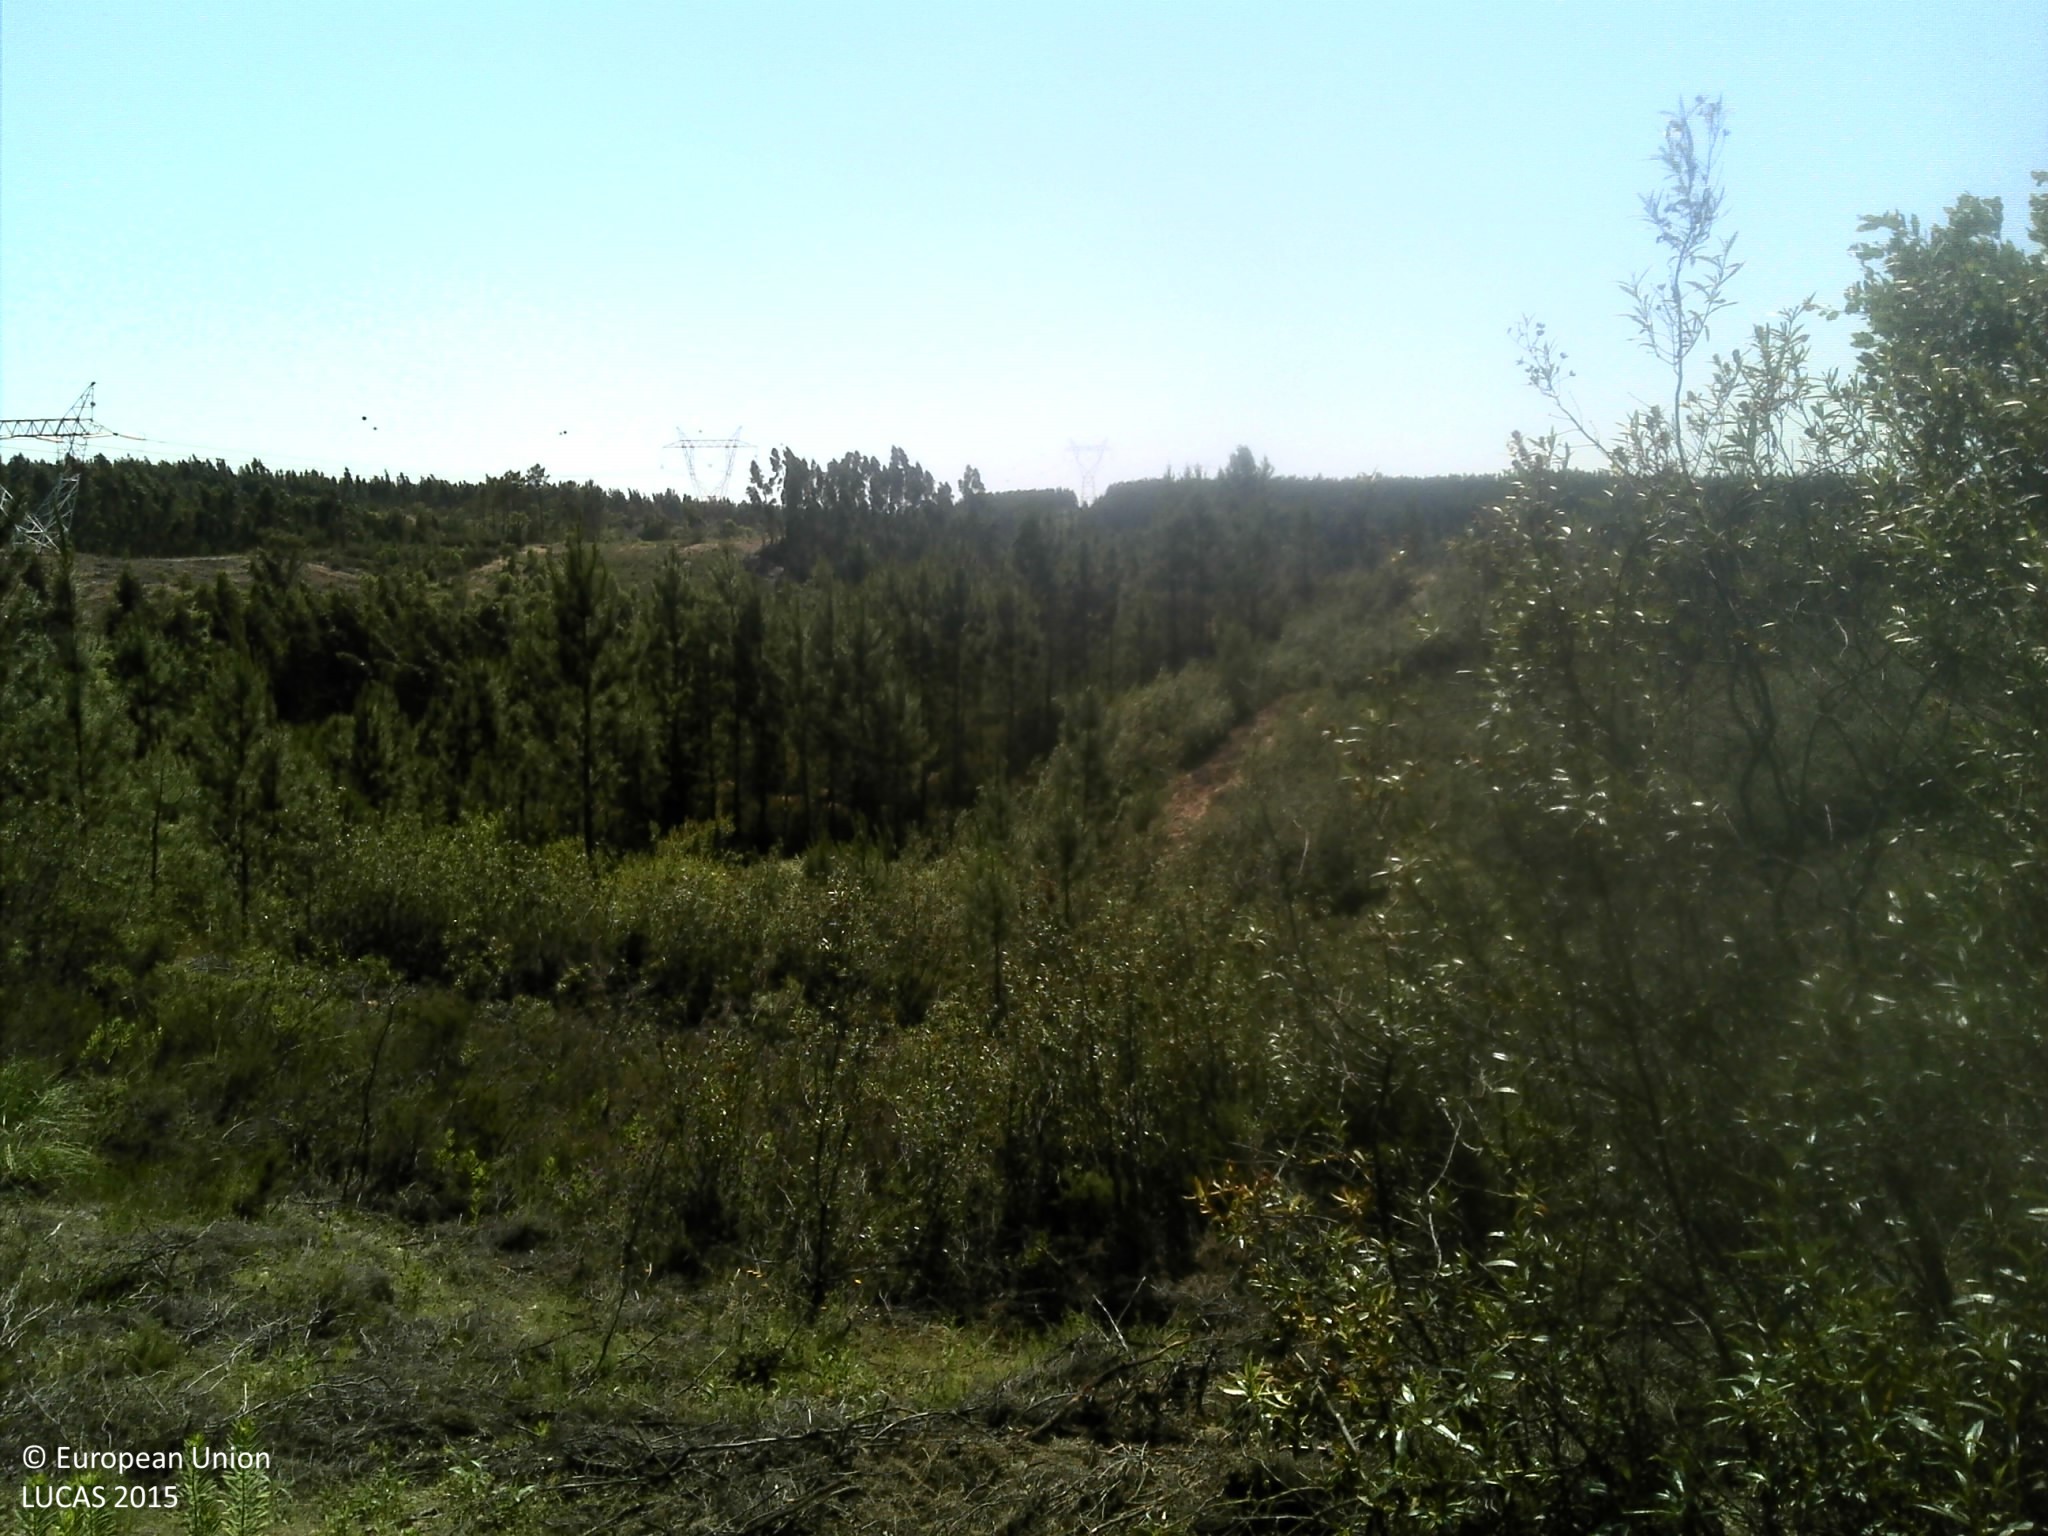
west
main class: Shrubland
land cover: Shrubland with sparse tree cover
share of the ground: 50 - 75 %
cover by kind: shrubs 75 %, unconsolidated bare surface 15 %, broadleaved forest trees 5 %, herbaceous plants 5 %
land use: Abandoned areas
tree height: > 5 m
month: May
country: PT
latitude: 39.5113
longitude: -8.3882
